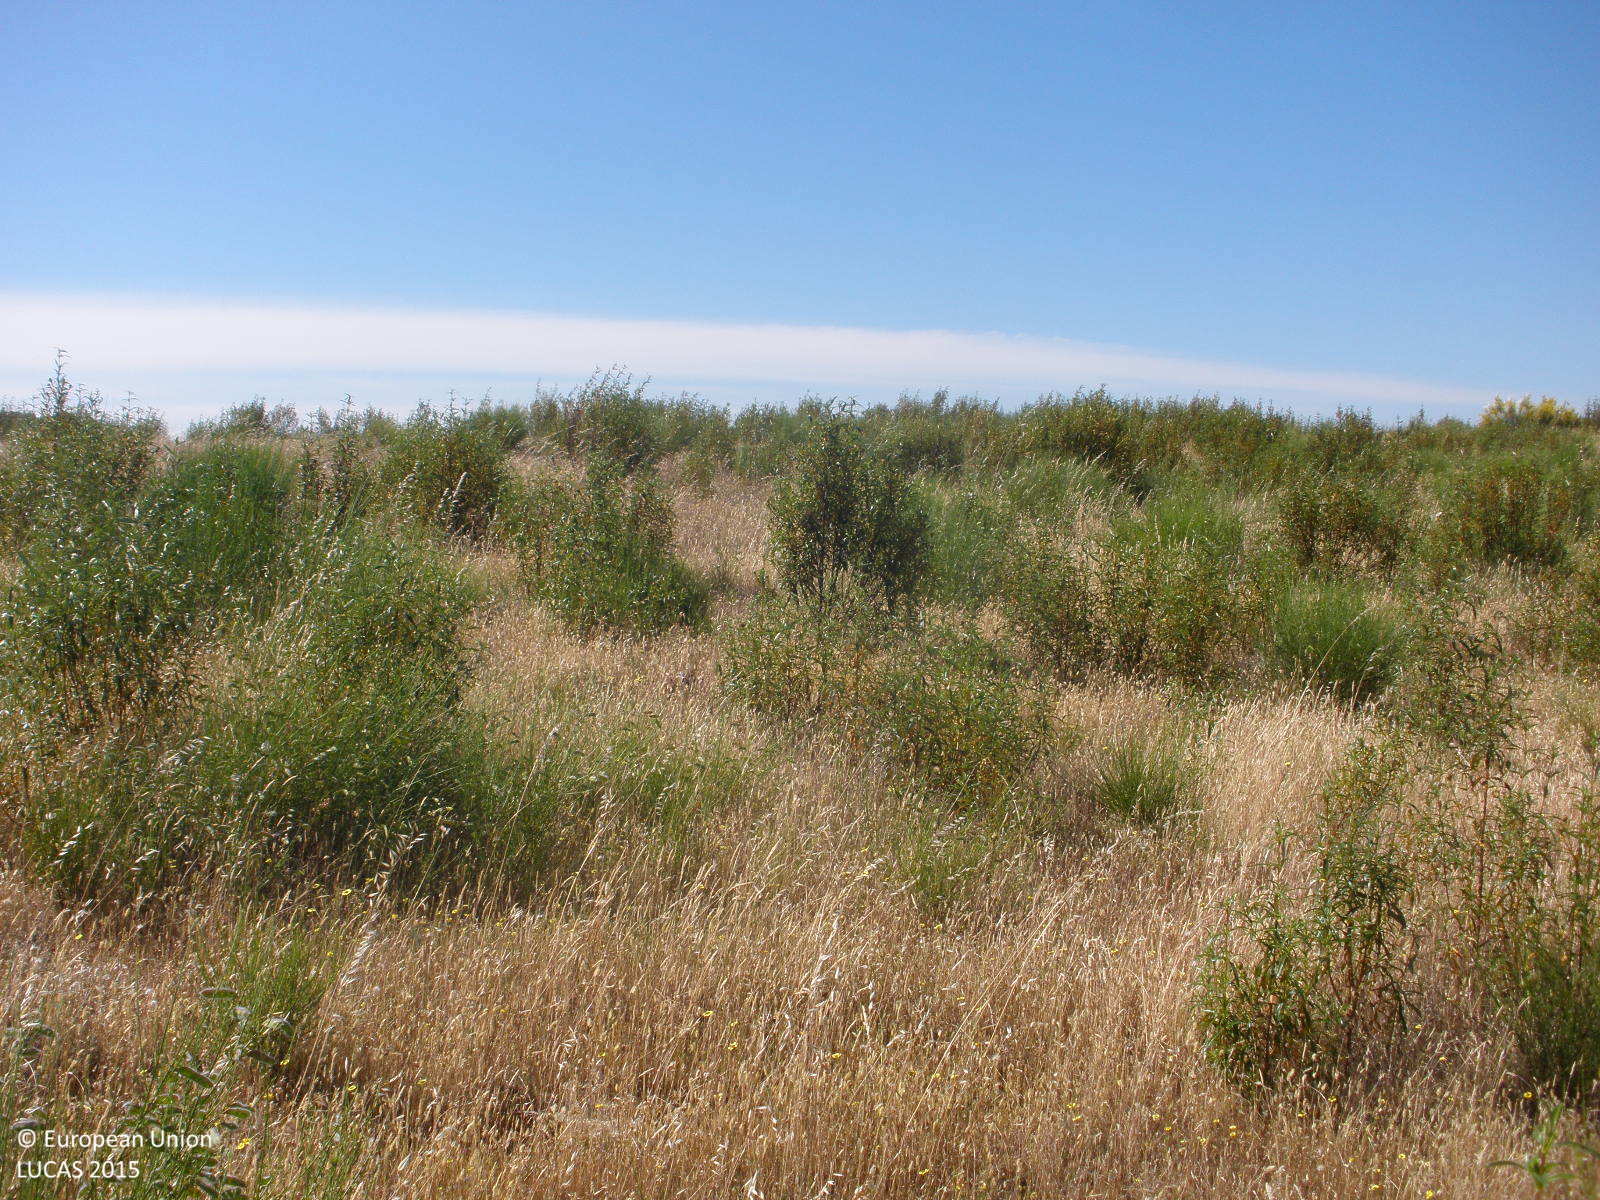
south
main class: Shrubland
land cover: Shrubland without tree cover
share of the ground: > 75 %
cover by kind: shrubs 60 %, herbaceous plants 40 %
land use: Agriculture (excluding fallow land and kitchen gardens)
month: May
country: ES
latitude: 40.2045
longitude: -6.2791
